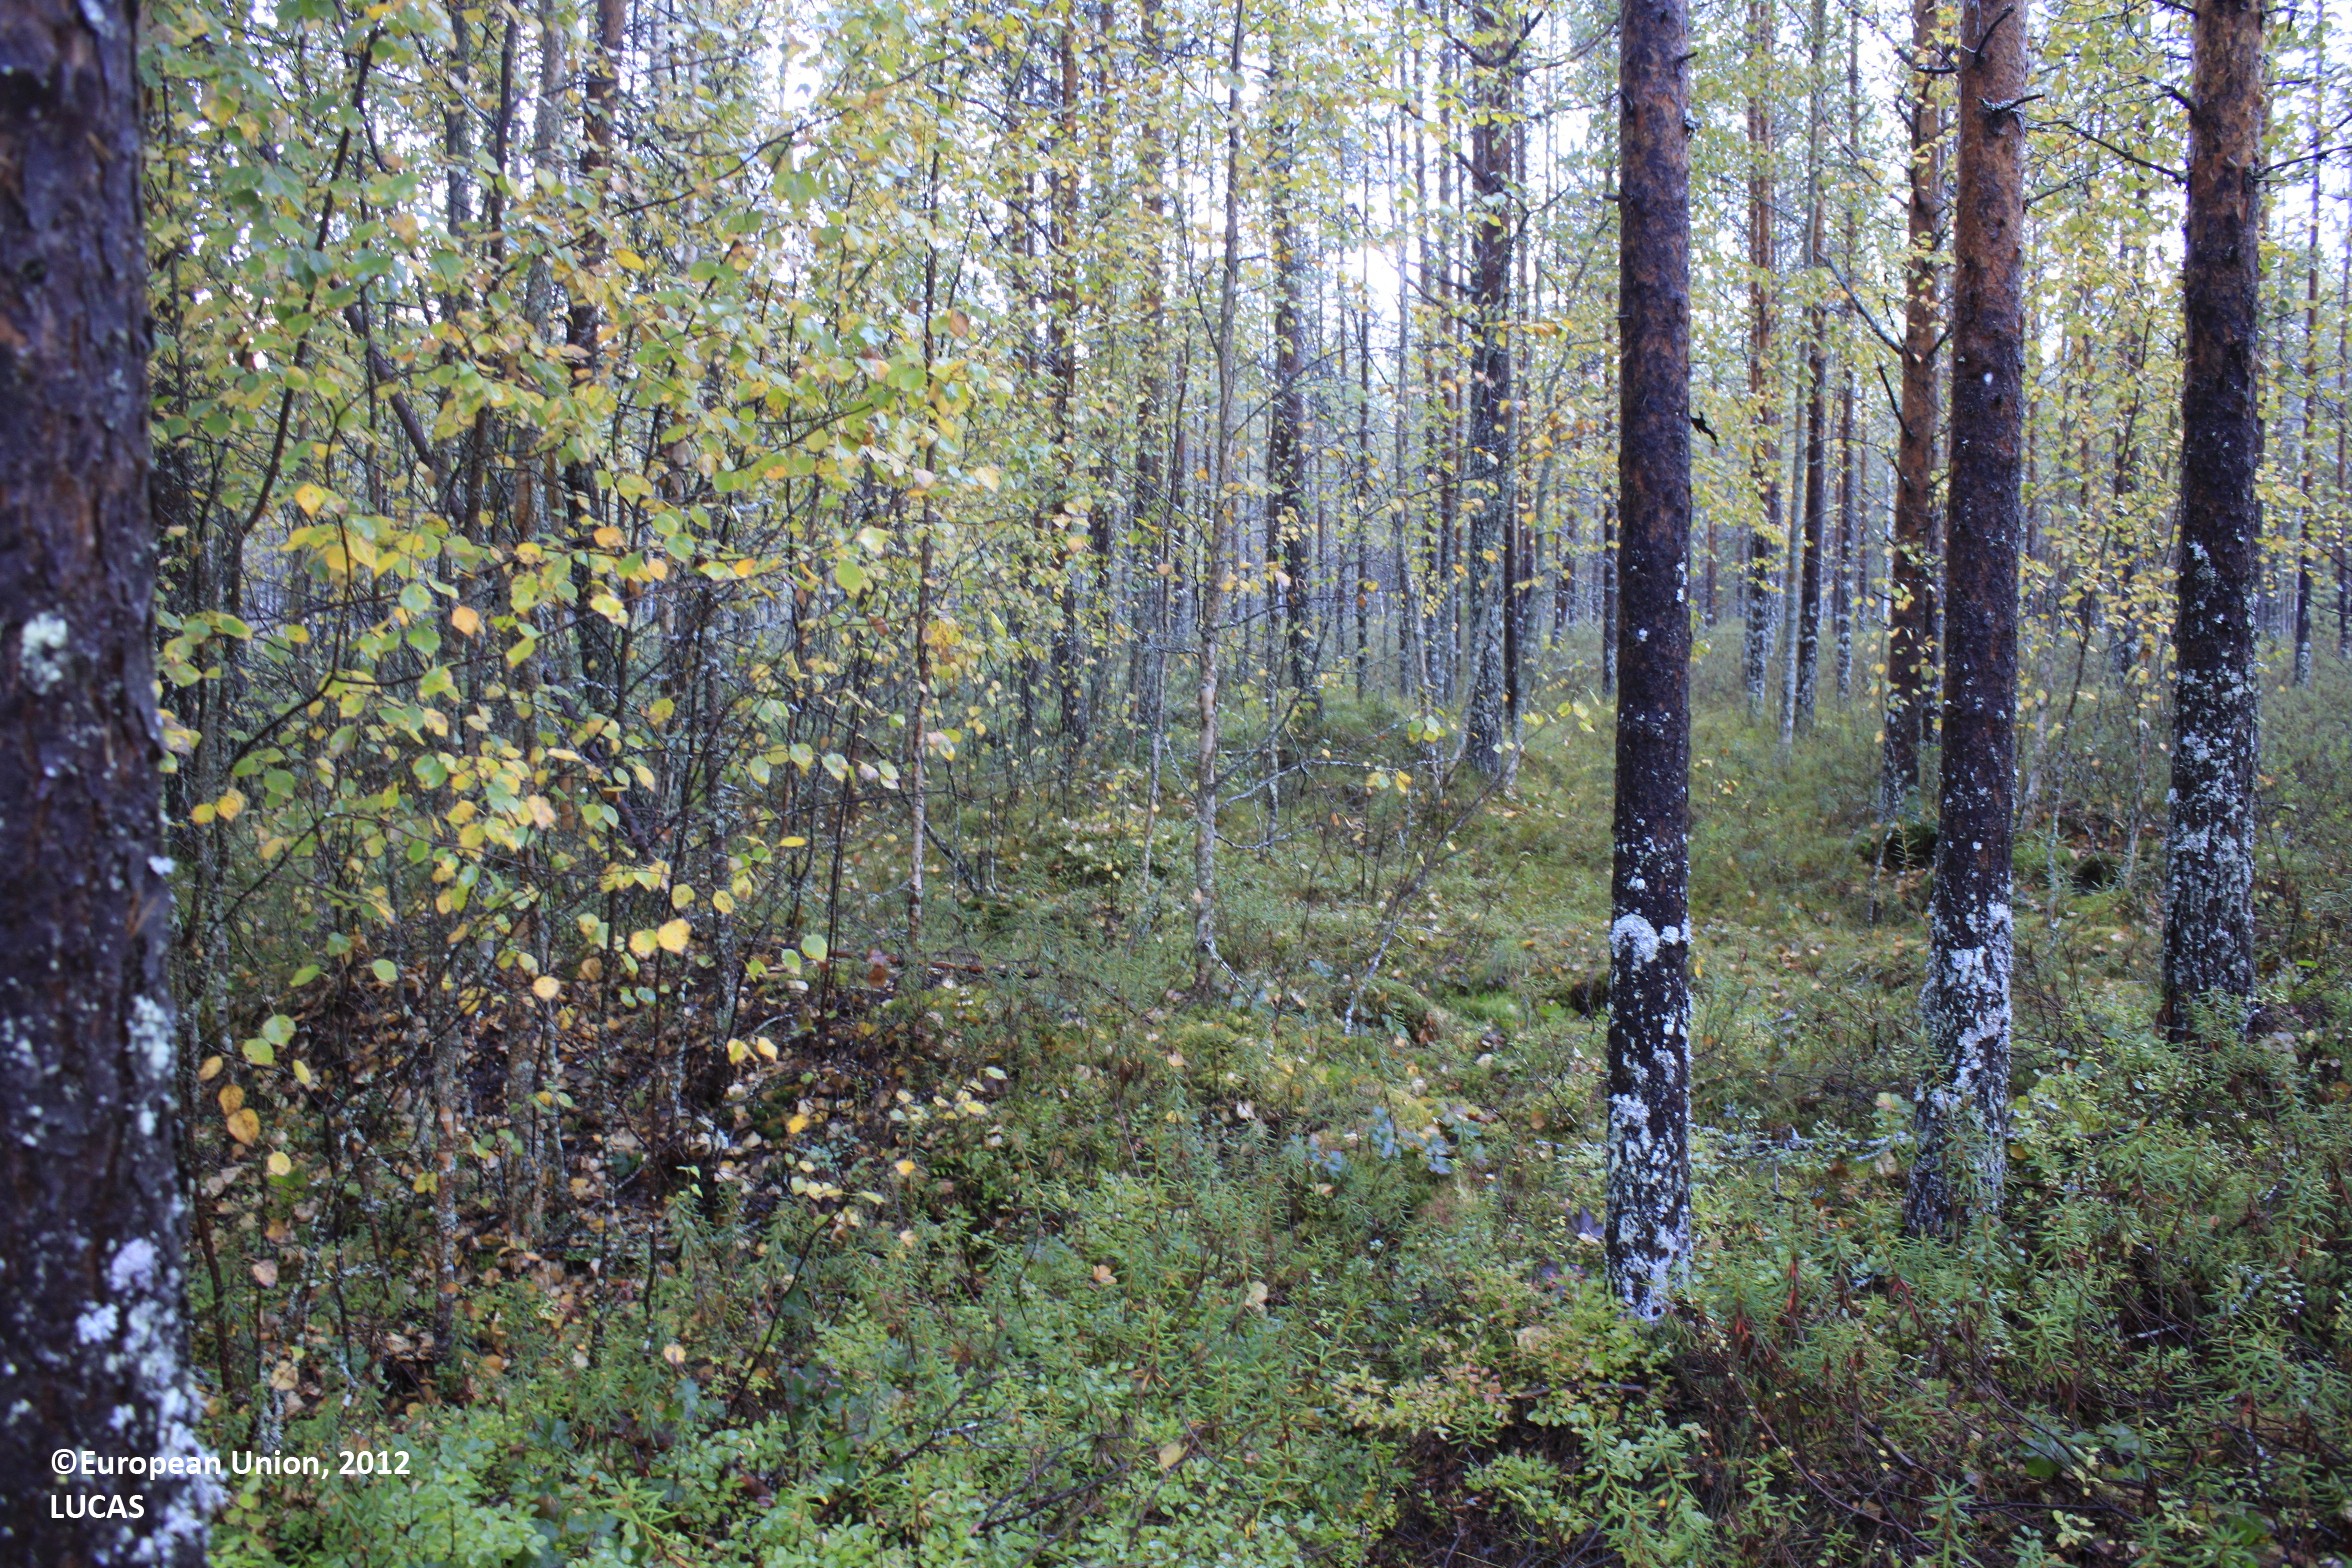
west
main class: Woodland
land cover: Pine dominated mixed woodland
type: boreal forest
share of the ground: 50 - 75 %
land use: Forestry
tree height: > 5 m
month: September
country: FI
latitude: 65.2752
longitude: 26.9806
